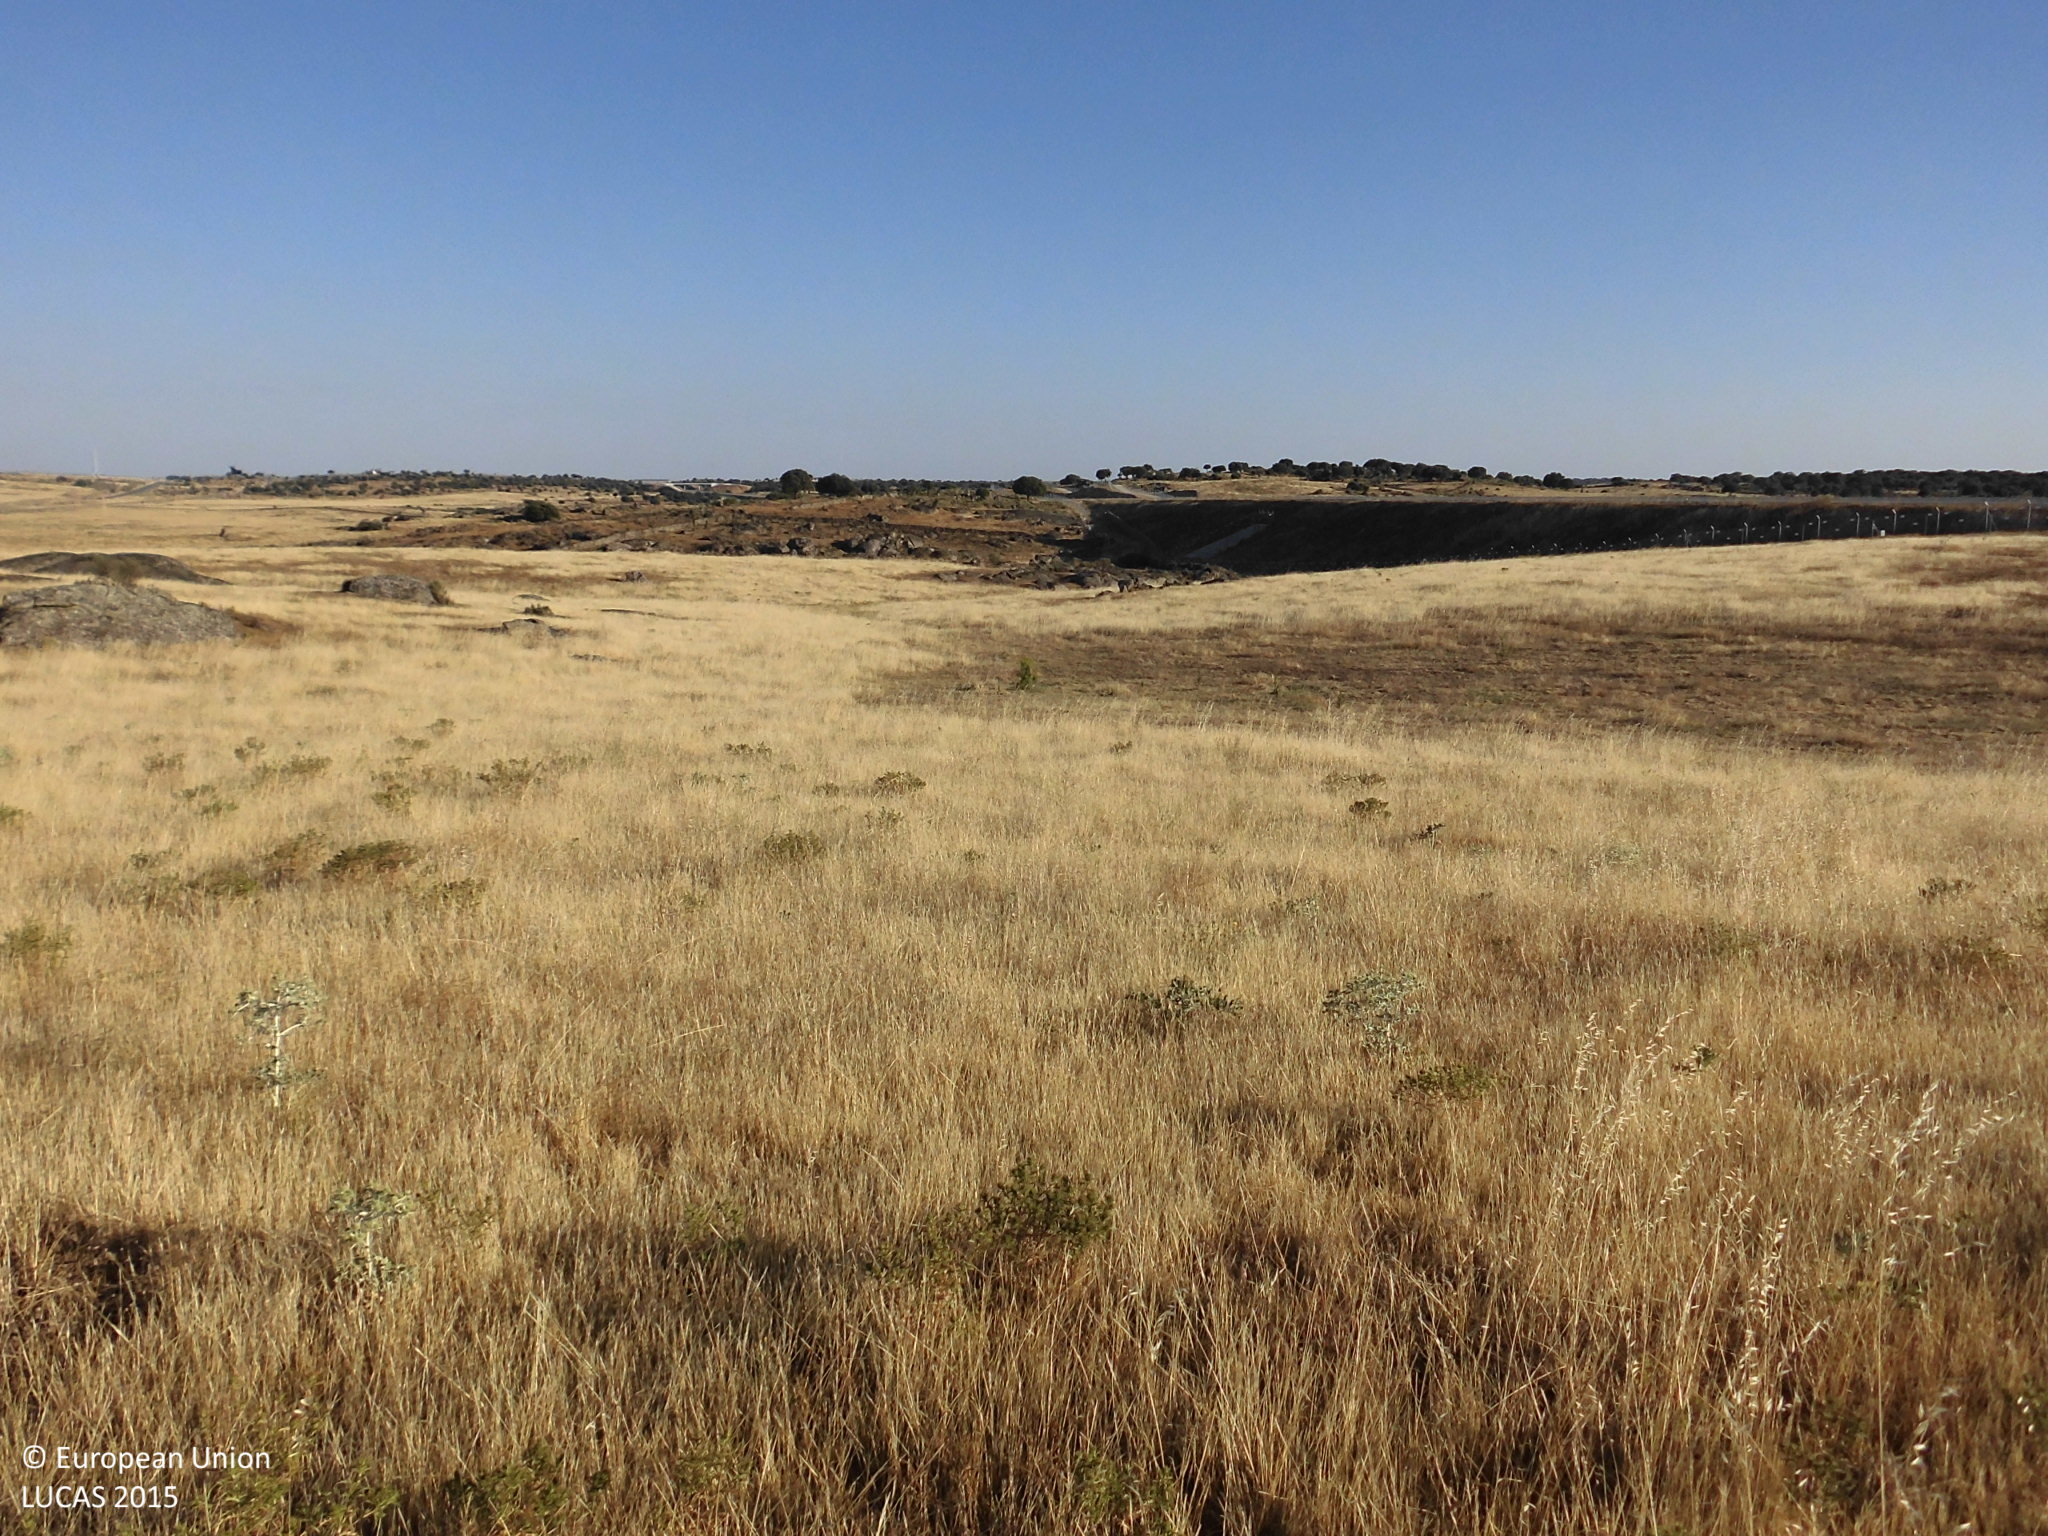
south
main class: Grassland
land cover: Grassland without tree/shrub cover
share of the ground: > 75 %
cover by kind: herbaceous plants 100 %
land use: Agriculture (excluding fallow land and kitchen gardens)
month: June
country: ES
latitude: 39.6172
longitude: -6.4855
